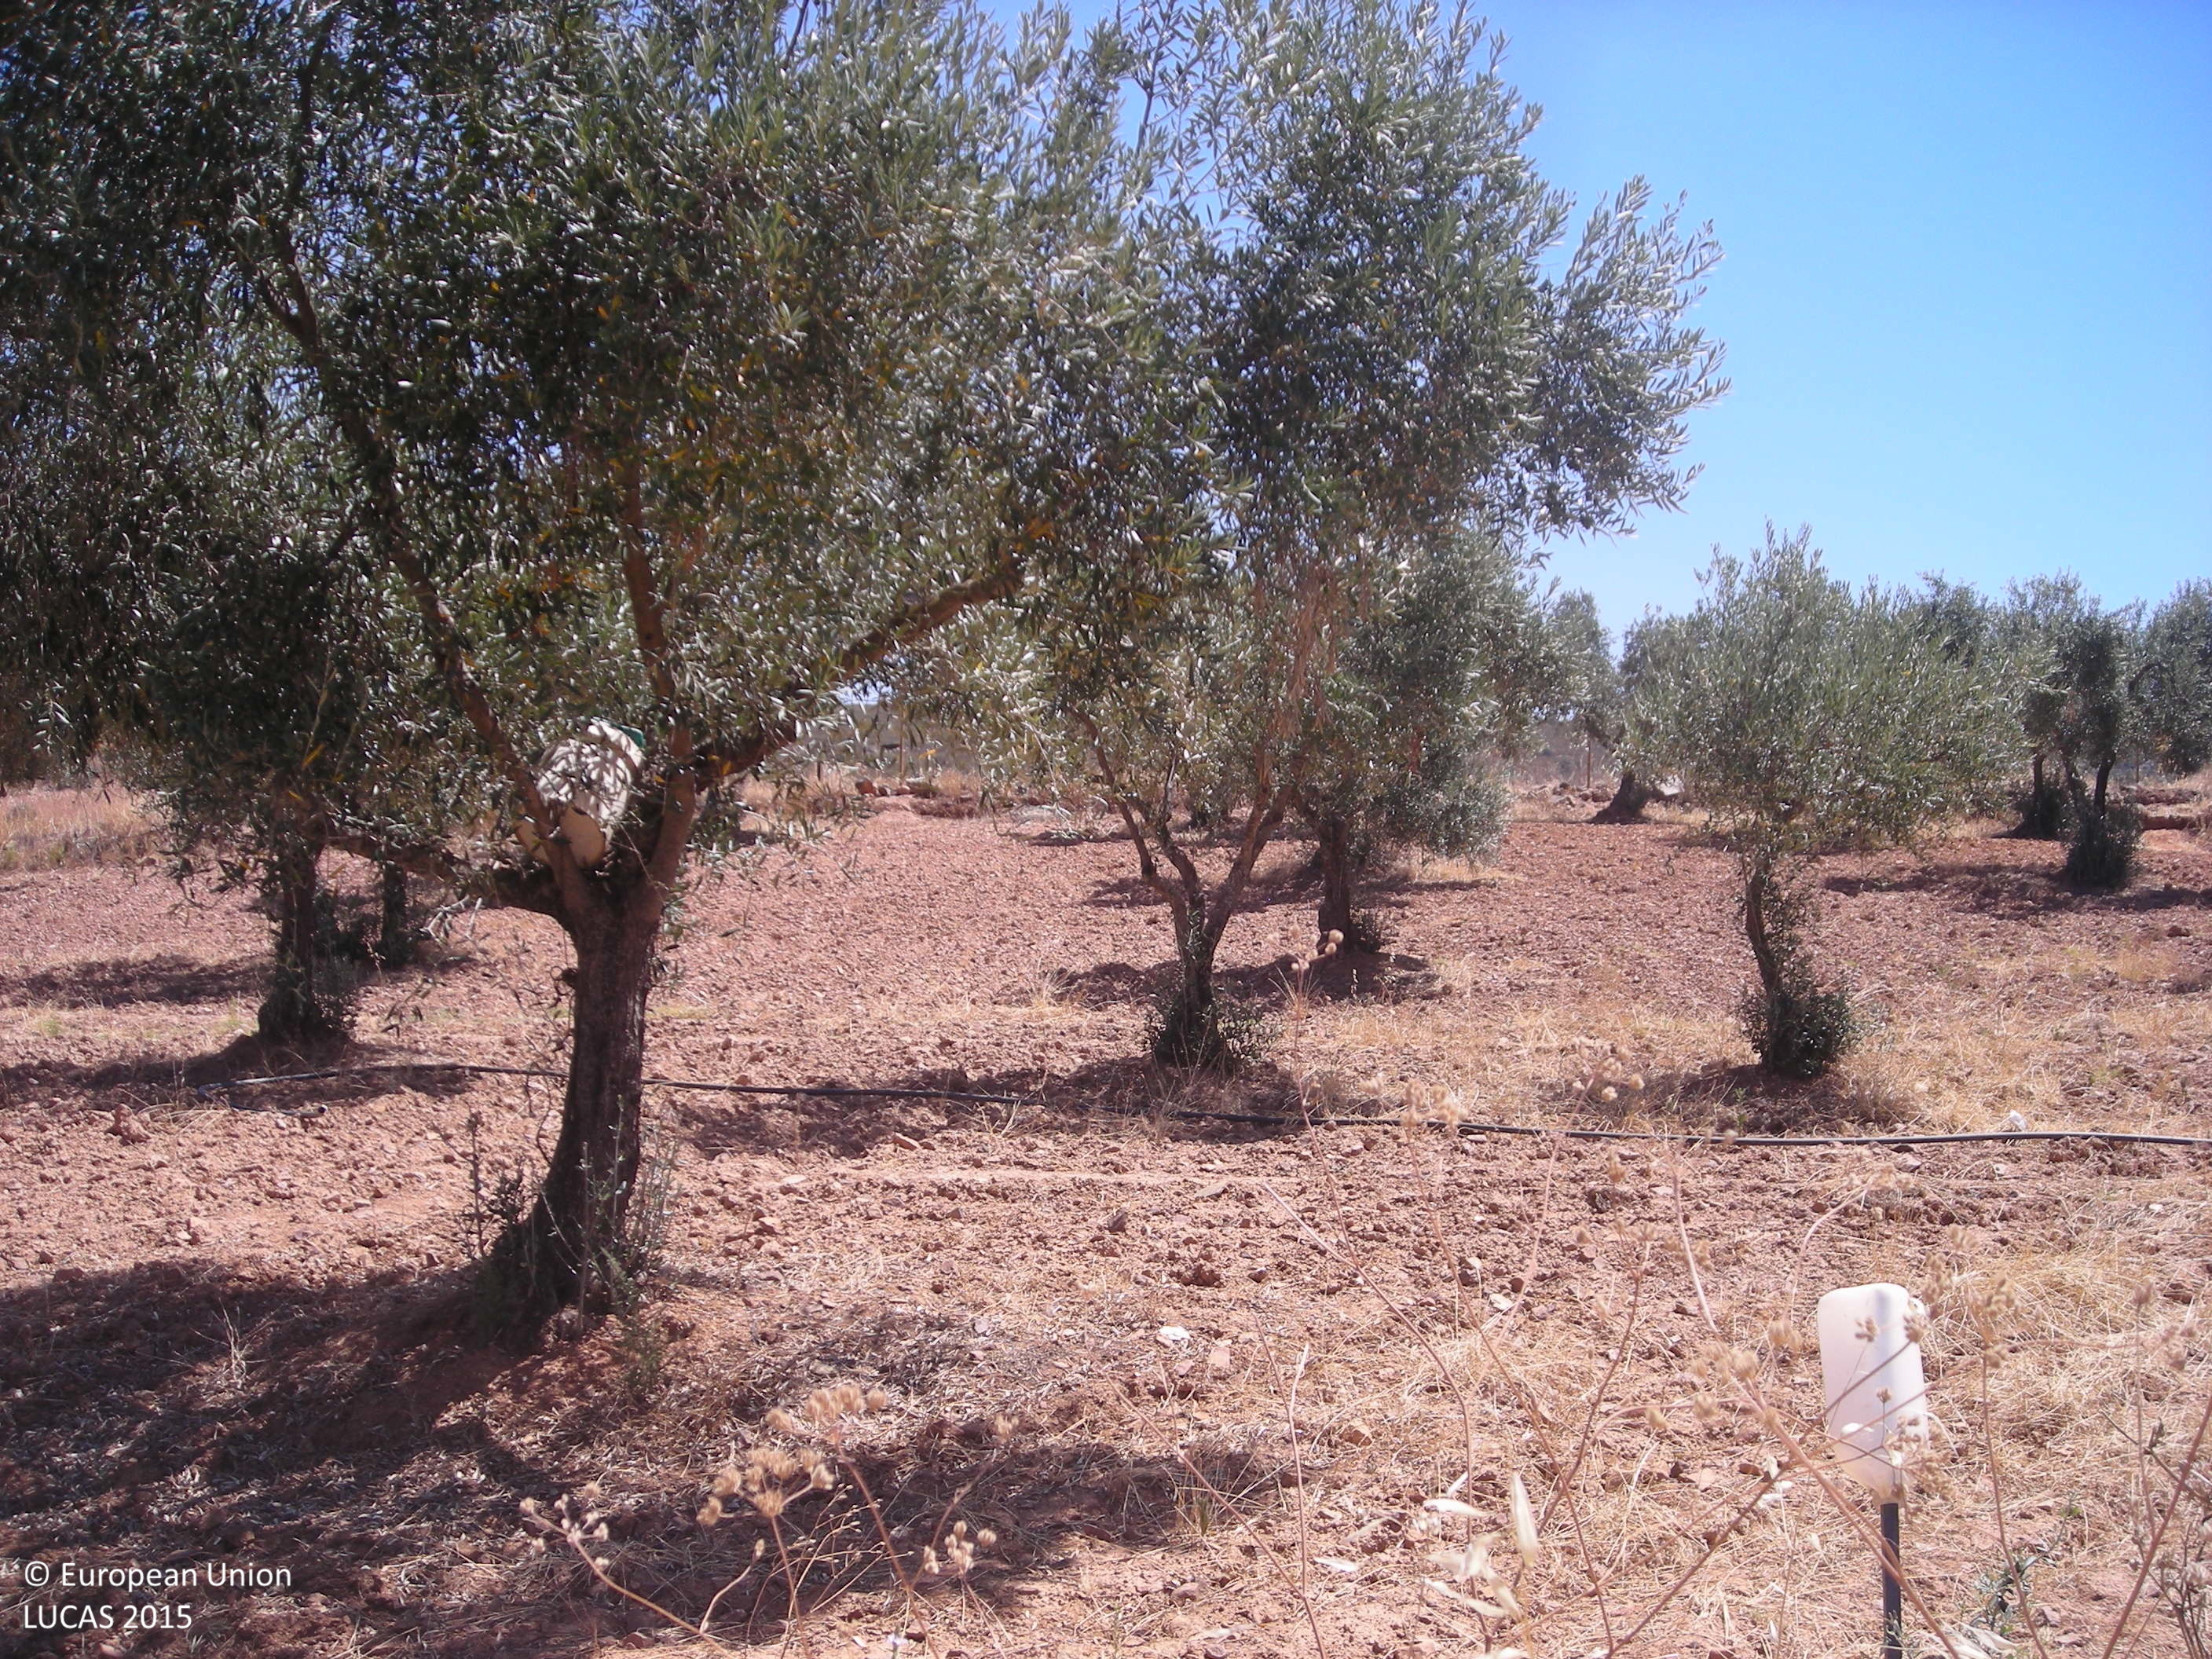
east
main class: Grassland
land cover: Grassland without tree/shrub cover
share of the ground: > 75 %
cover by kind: herbaceous plants 100 %
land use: Agriculture (excluding fallow land and kitchen gardens)
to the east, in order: Grassland without tree/shrub cover; Single bushes/trees; Grassland without tree/shrub cover; Fences; Grassland without tree/shrub cover; Fences; Shrubland with sparse tree cover; Fences; Grassland without tree/shrub cover
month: July
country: ES
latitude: 38.7247
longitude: -5.8844
